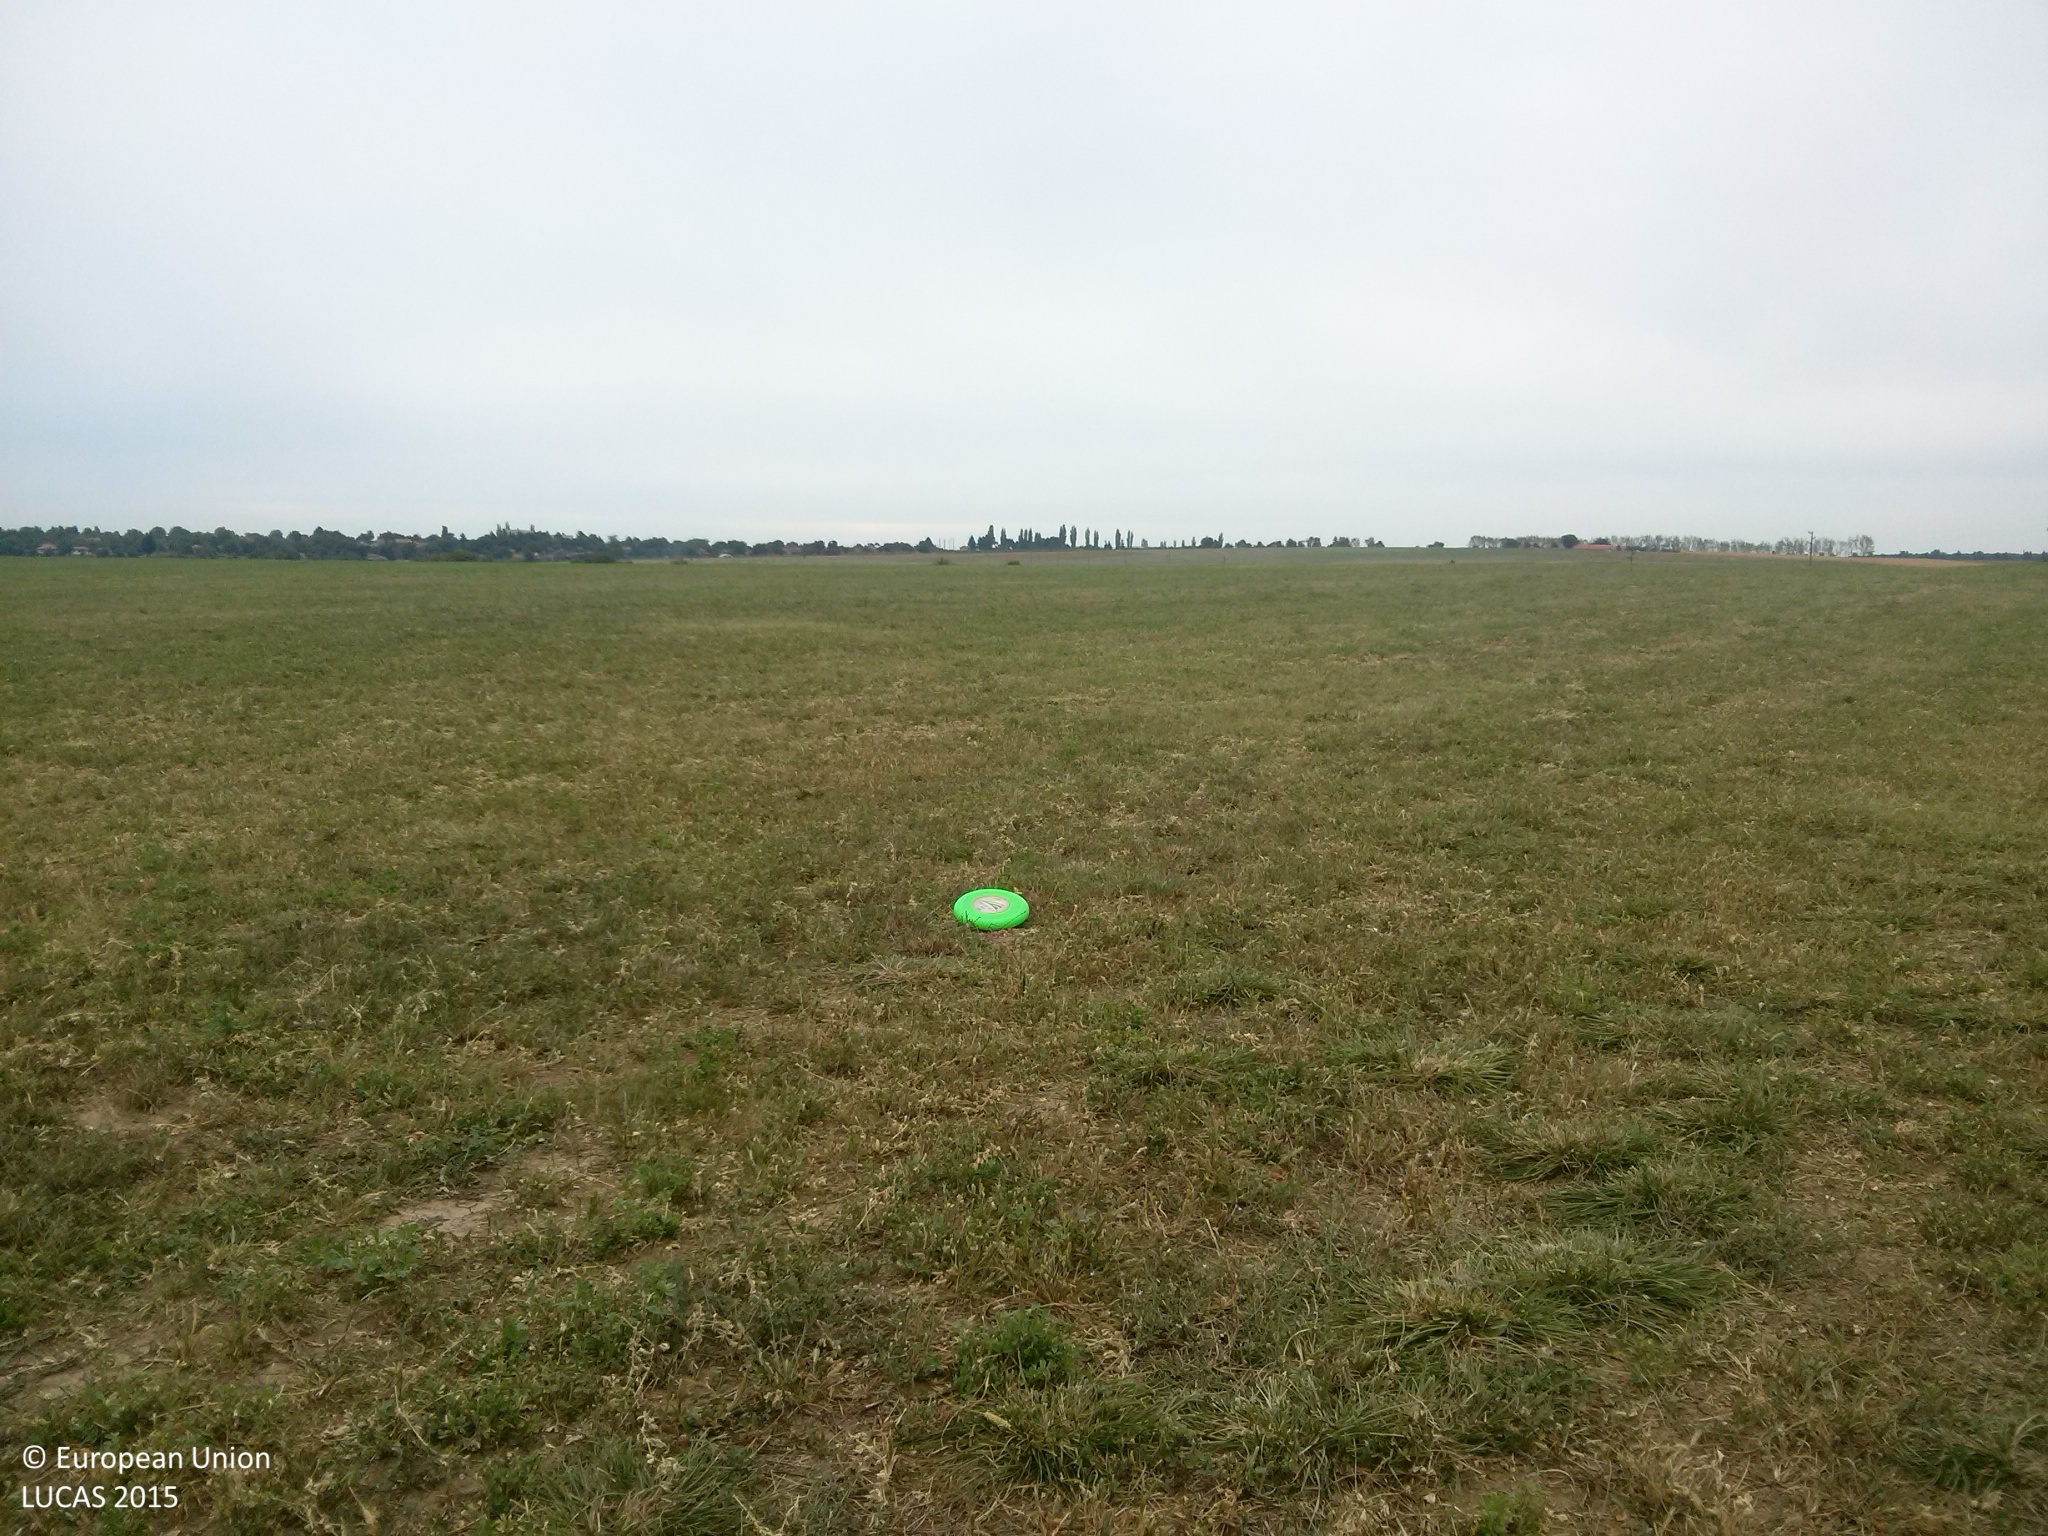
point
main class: Cropland
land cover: Lucerne
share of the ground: 50 - 75 %
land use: Agriculture (excluding fallow land and kitchen gardens)
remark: Harvested field
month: September
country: BG
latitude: 43.7469
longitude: 26.7670
